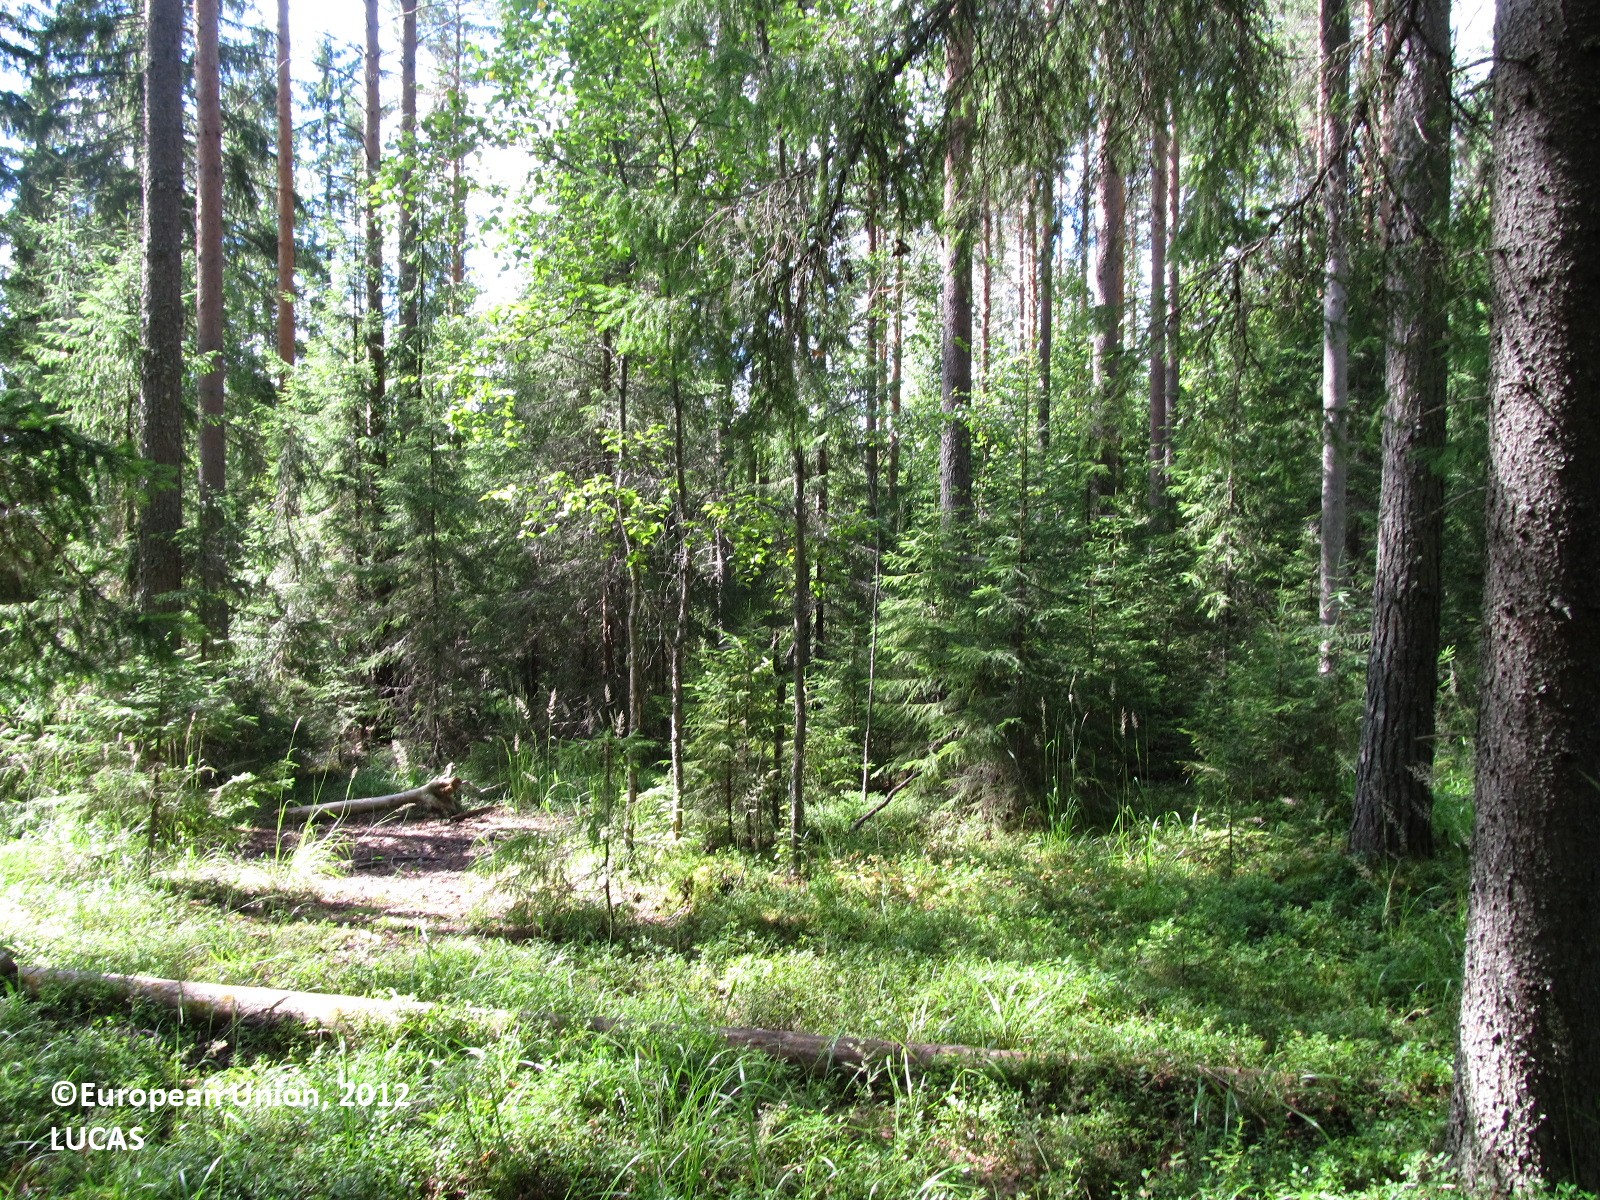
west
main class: Woodland
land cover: Spruce dominated coniferous woodland
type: boreal forest
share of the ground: 50 - 75 %
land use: Forestry
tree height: > 5 m
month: July
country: FI
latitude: 61.9482
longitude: 27.9336
